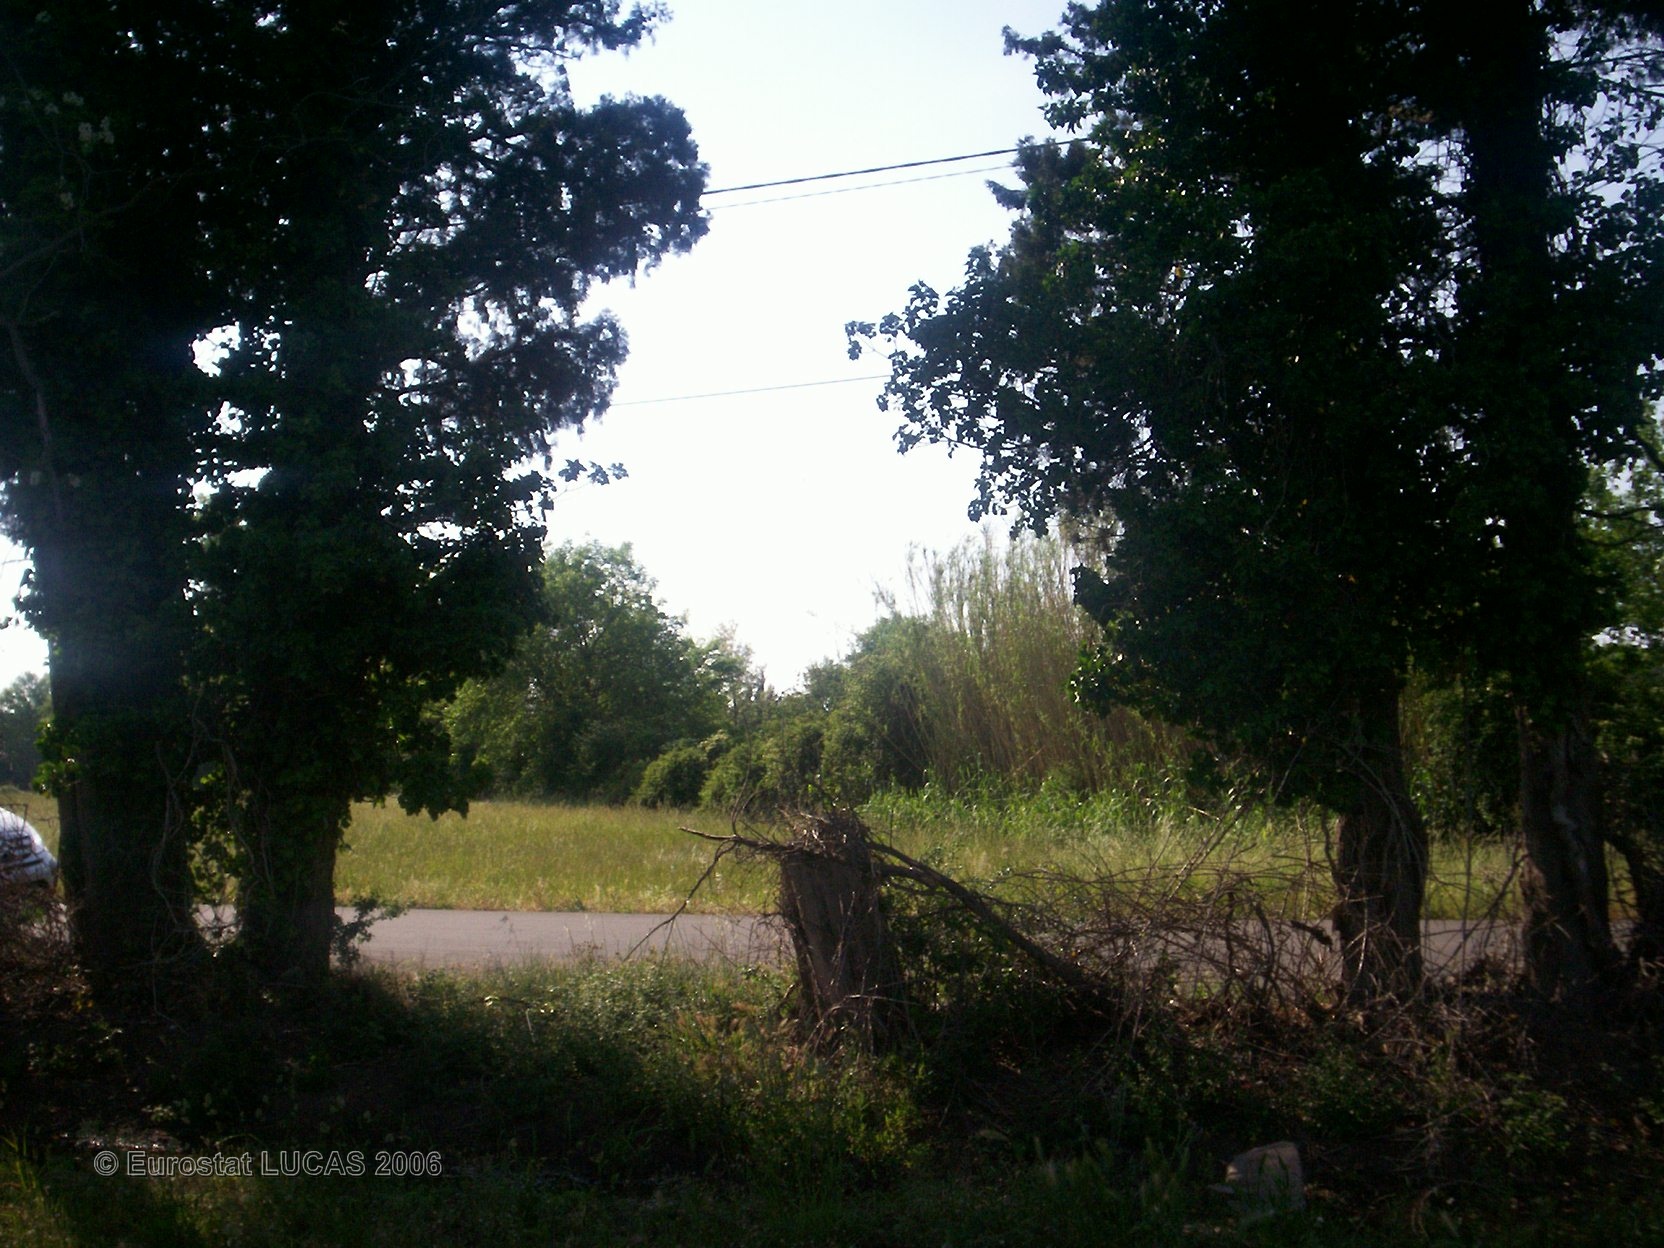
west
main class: Grassland
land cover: Grassland without tree/shrub cover
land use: Agriculture (excluding fallow land and kitchen gardens)
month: May
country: FR
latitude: 43.9355
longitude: 4.8886
